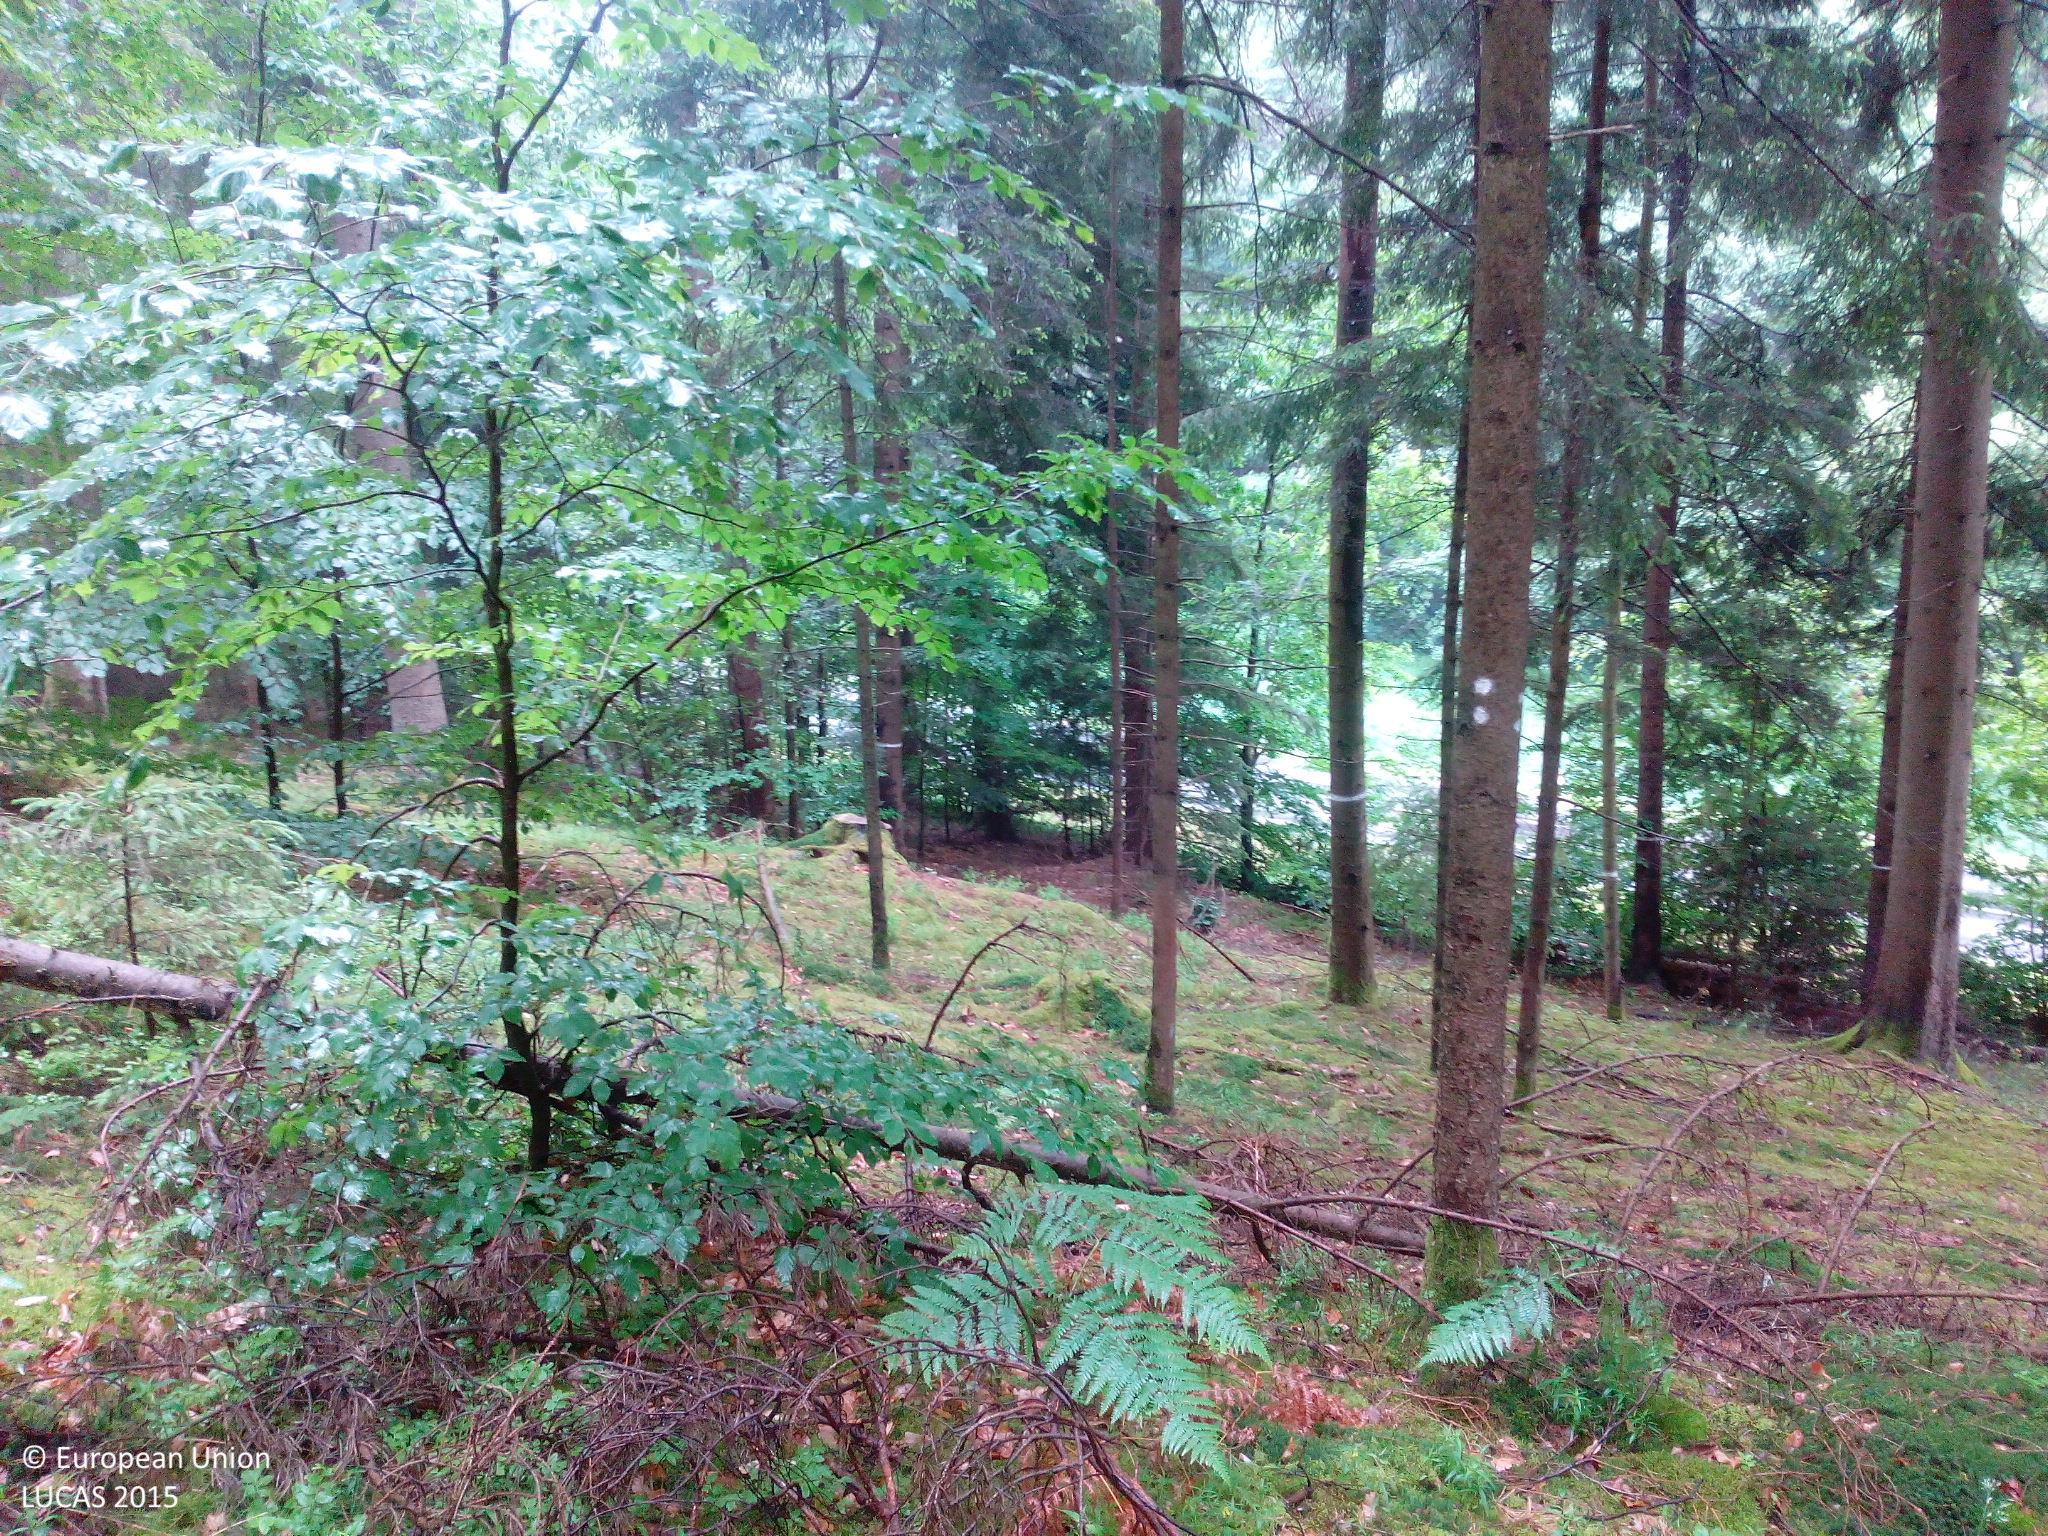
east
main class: Woodland
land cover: Spruce dominated coniferous woodland
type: hemiboreal forest and nemoral coniferous forest and mixed broadleaved-coniferous forest
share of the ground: 50 - 75 %
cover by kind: coniferous forest trees 70 %, lichens and mosses 15 %, herbaceous plants 10 %, broadleaved forest trees 5 %
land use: Forestry
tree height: > 5 m
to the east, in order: Spruce dominated coniferous woodland; Grass margins; Ditches and canals; Grass margins; Paved roads, cycling and walking lanes; Grass margins; Broadleaved woodland; Rivers and streams; Spruce dominated mixed woodland; Tracks; Spruce dominated coniferous woodland
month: June
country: DE
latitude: 50.1392
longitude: 11.4408
